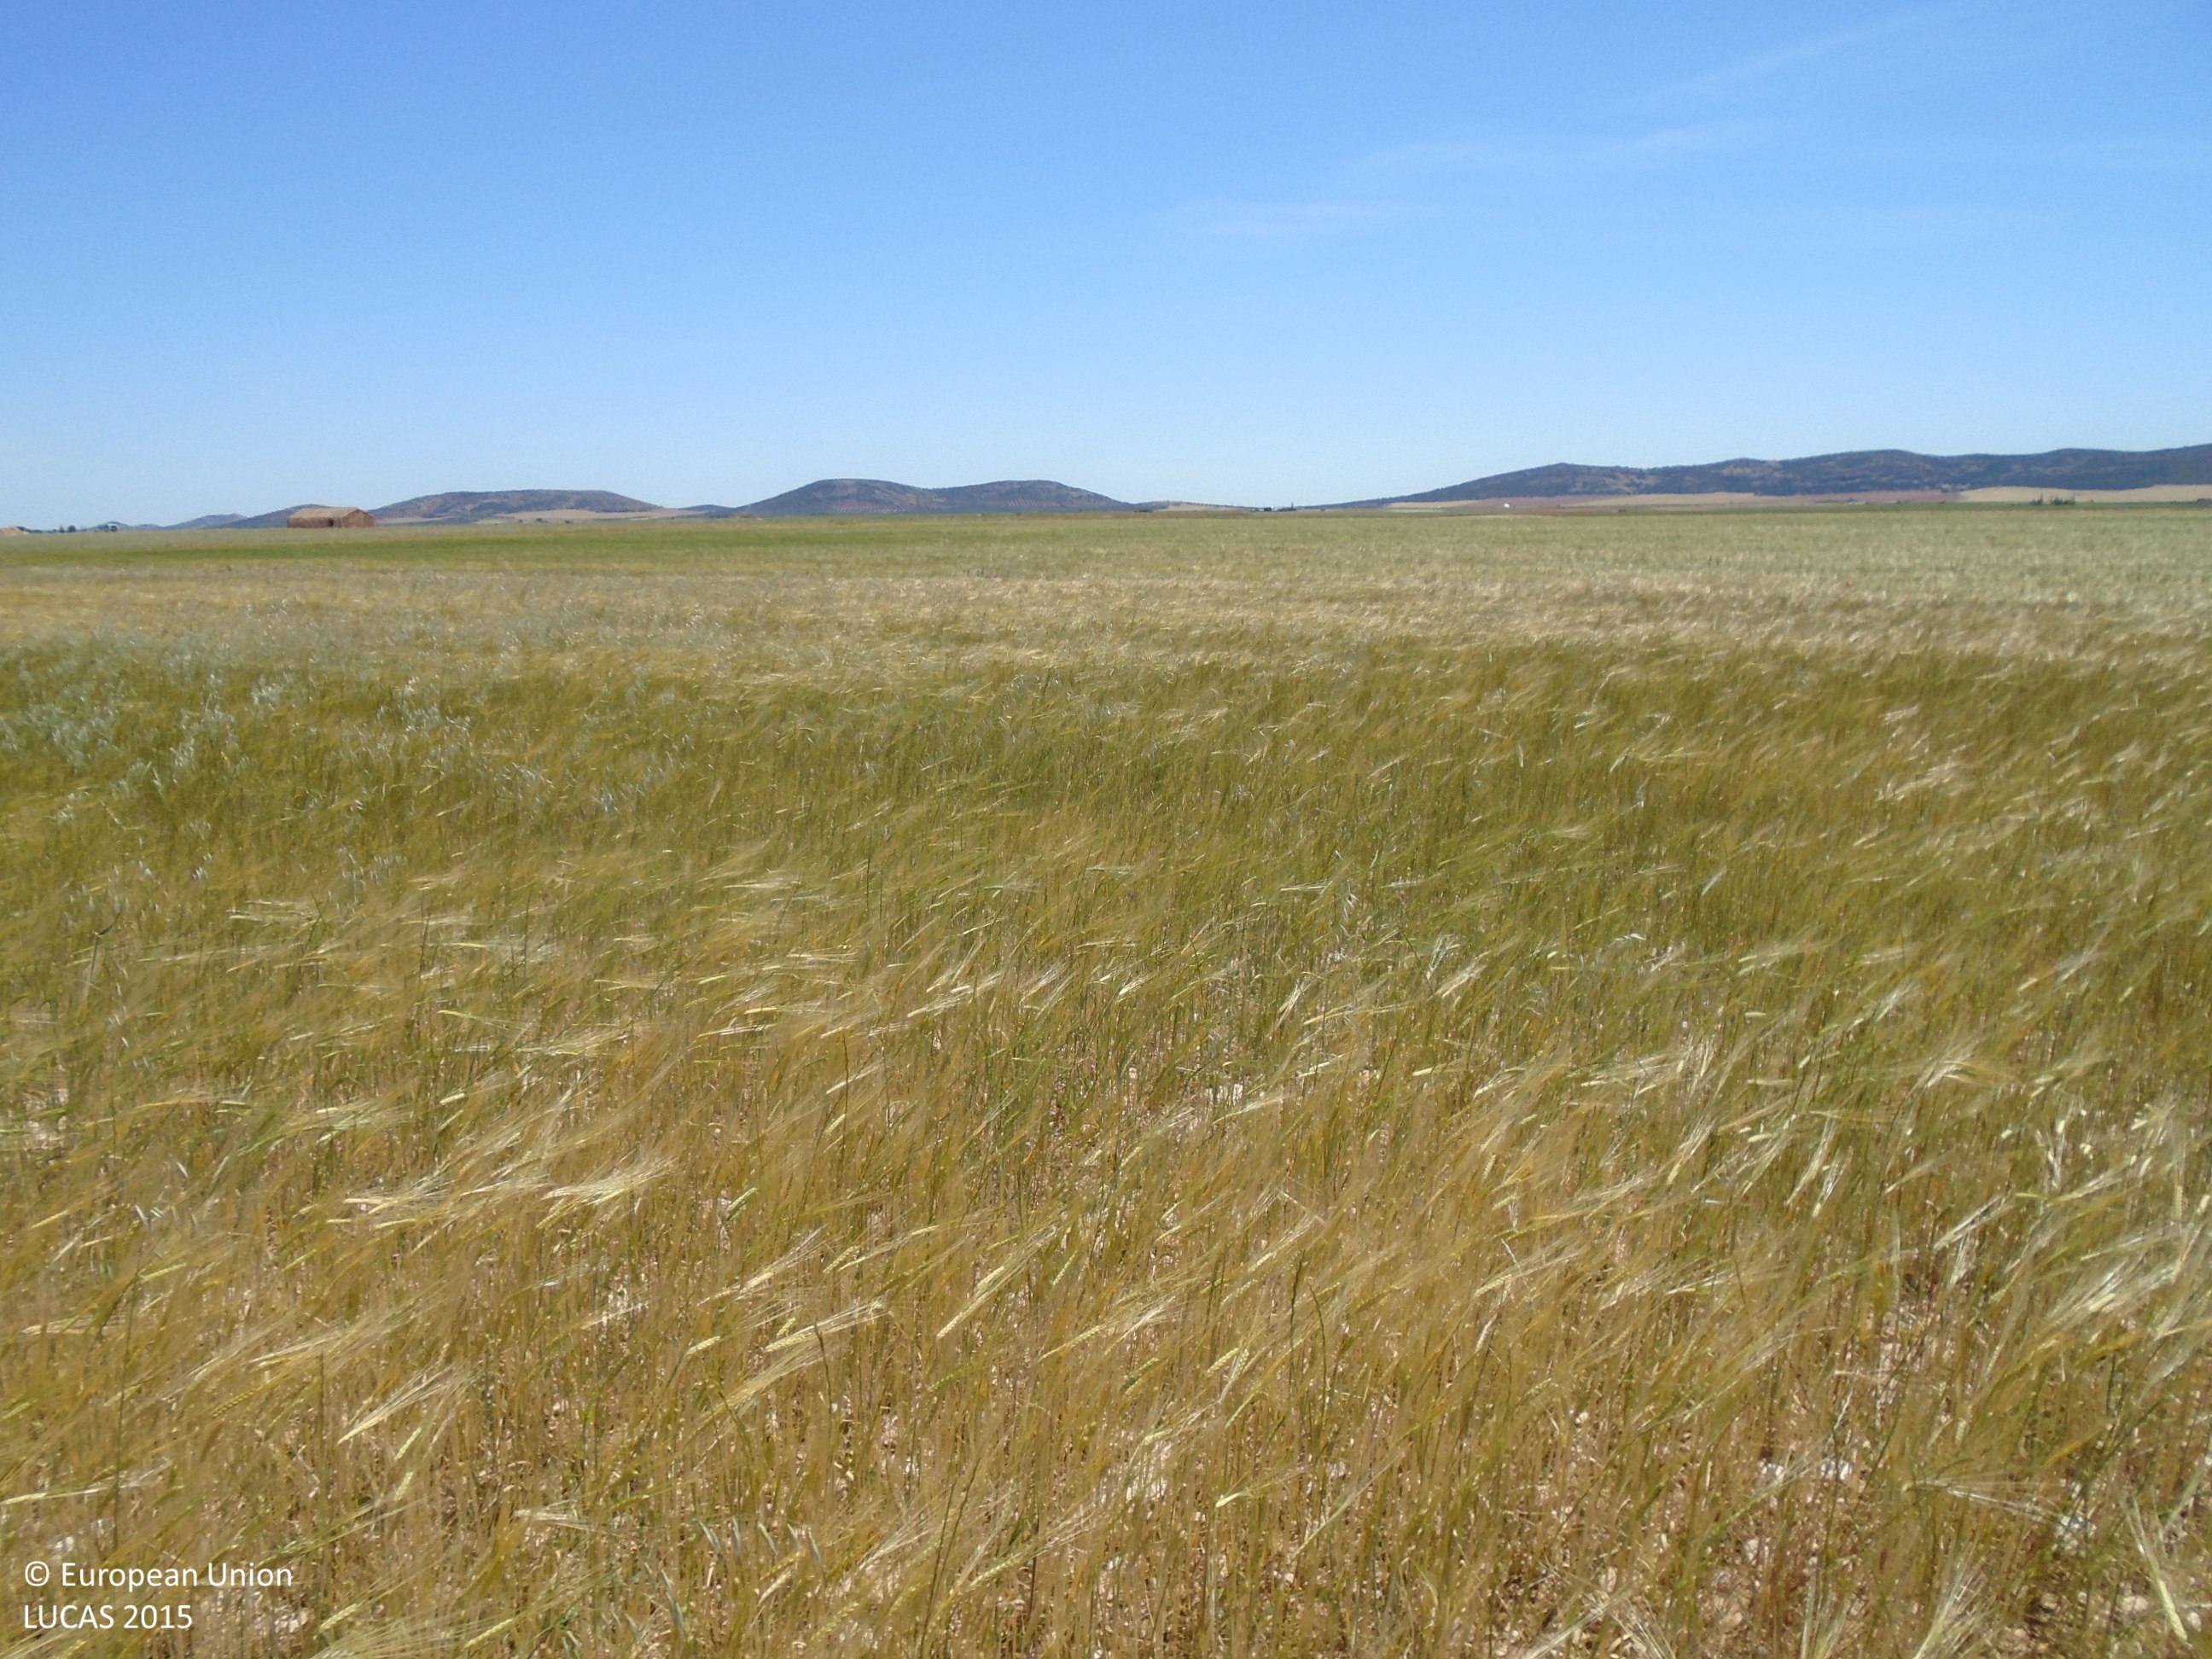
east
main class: Cropland
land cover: Barley
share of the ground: > 75 %
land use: Agriculture (excluding fallow land and kitchen gardens)
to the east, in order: Barley; Grass margins; Barley; Grass margins; Barley; Grass margins; Barley; Grass margins; Other bare soil
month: May
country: ES
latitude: 39.4978
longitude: -3.7356
